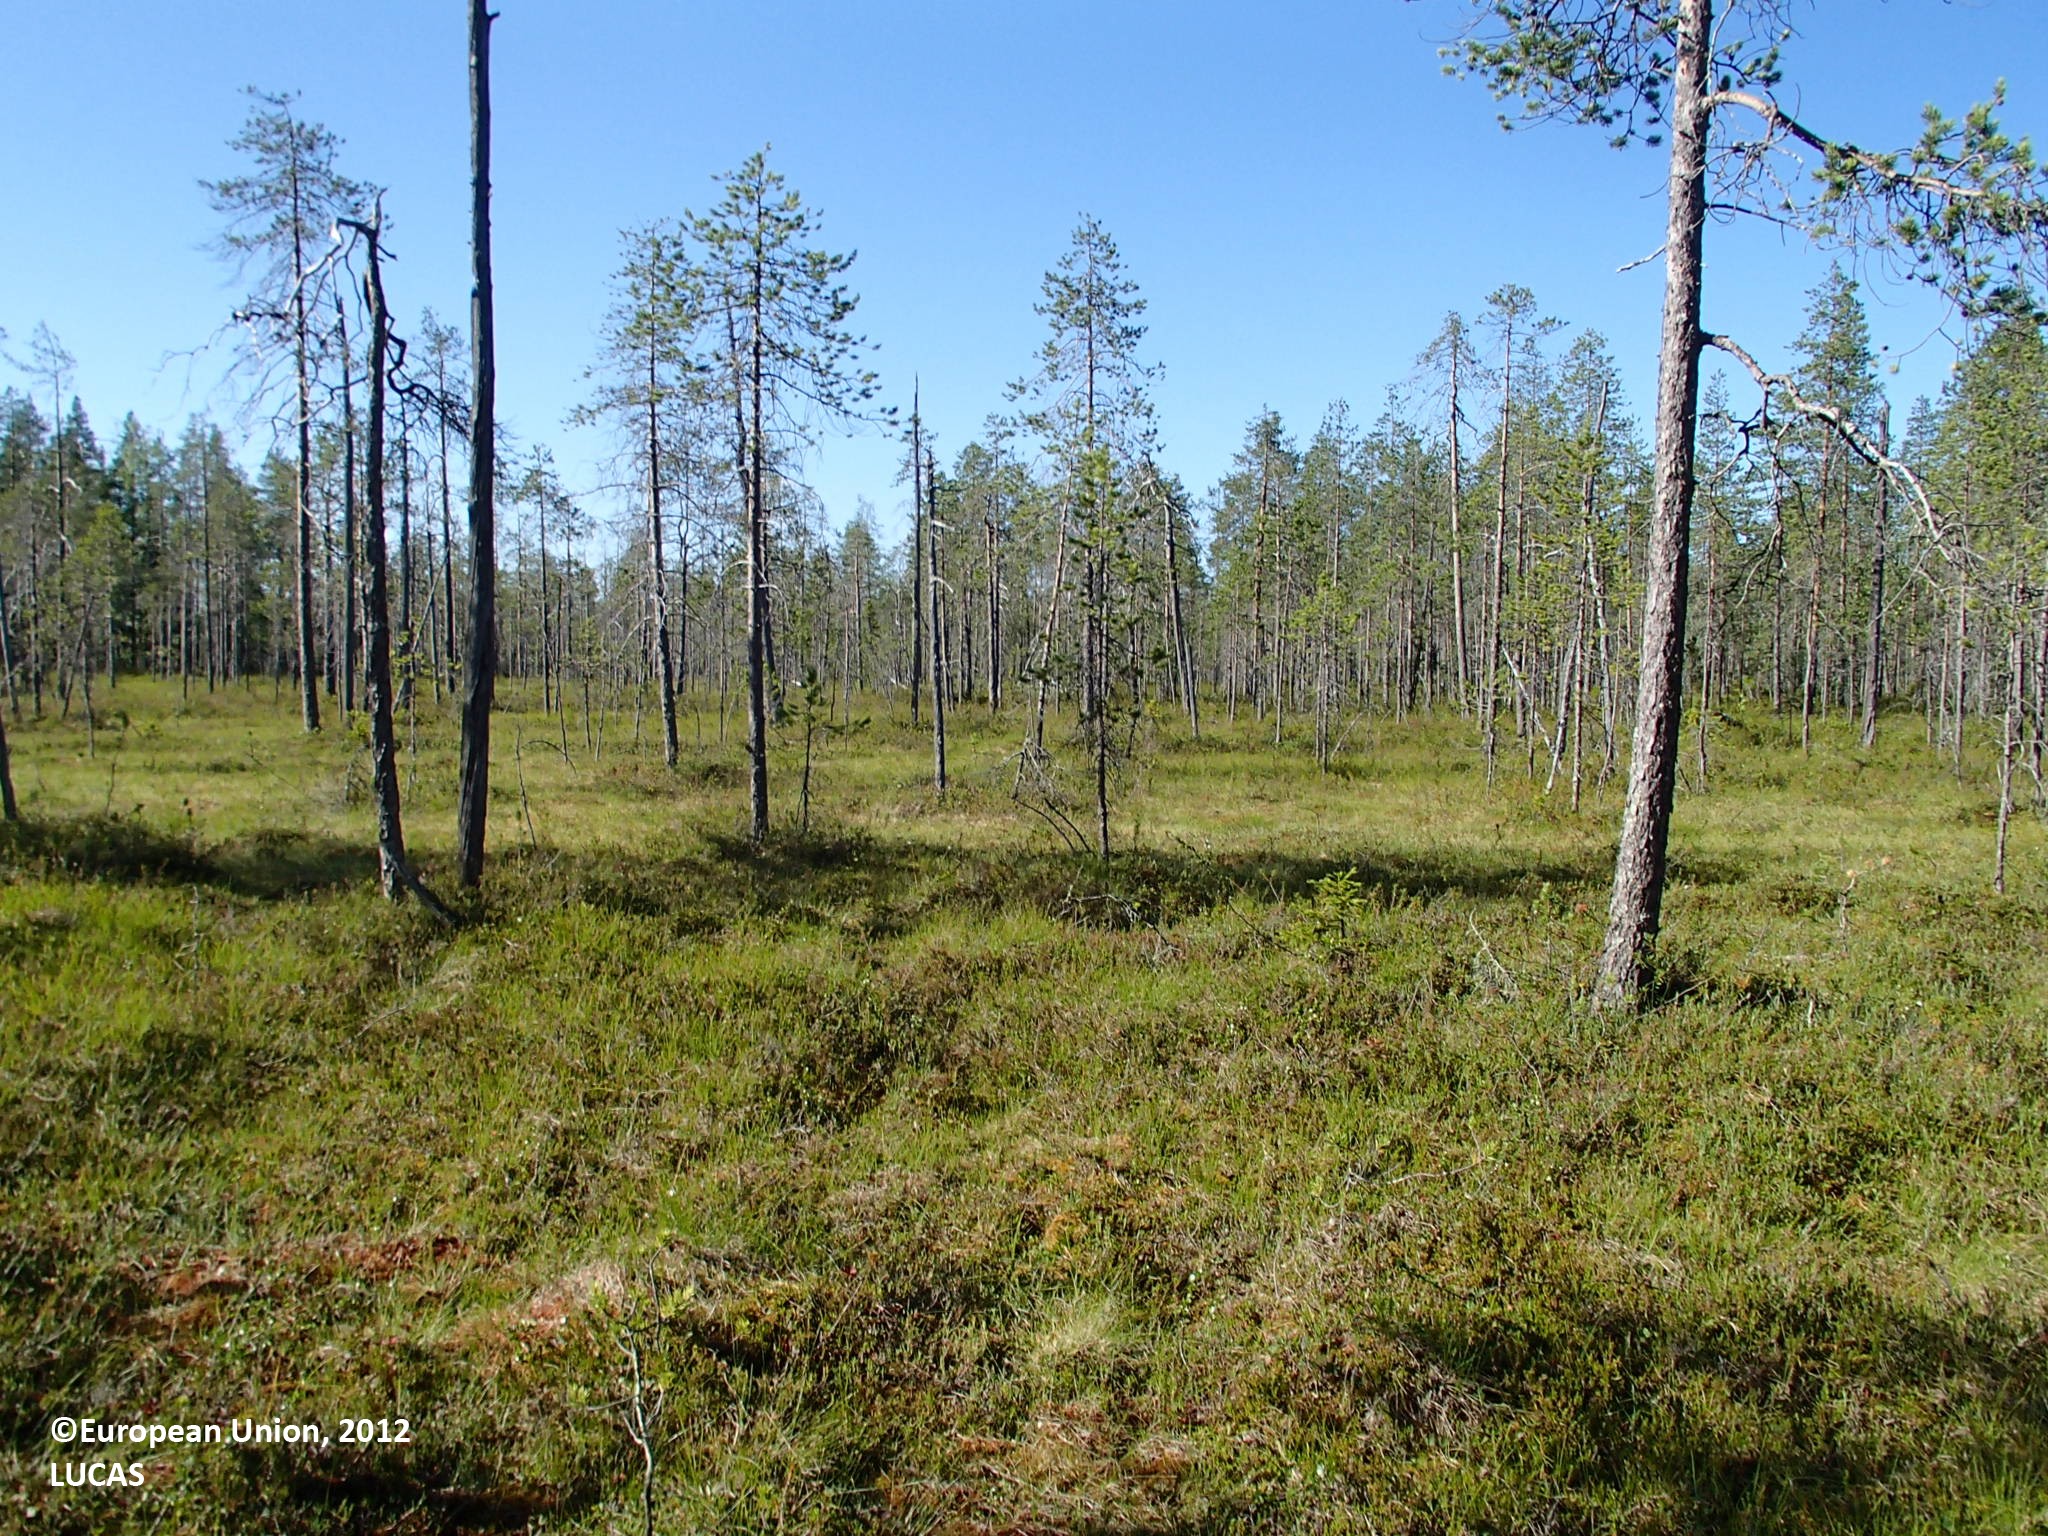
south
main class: Woodland
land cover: Pine dominated coniferous woodland
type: boreal forest
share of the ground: 10 - 25 %
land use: Forestry
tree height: > 5 m
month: July
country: FI
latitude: 66.8268
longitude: 25.5688
